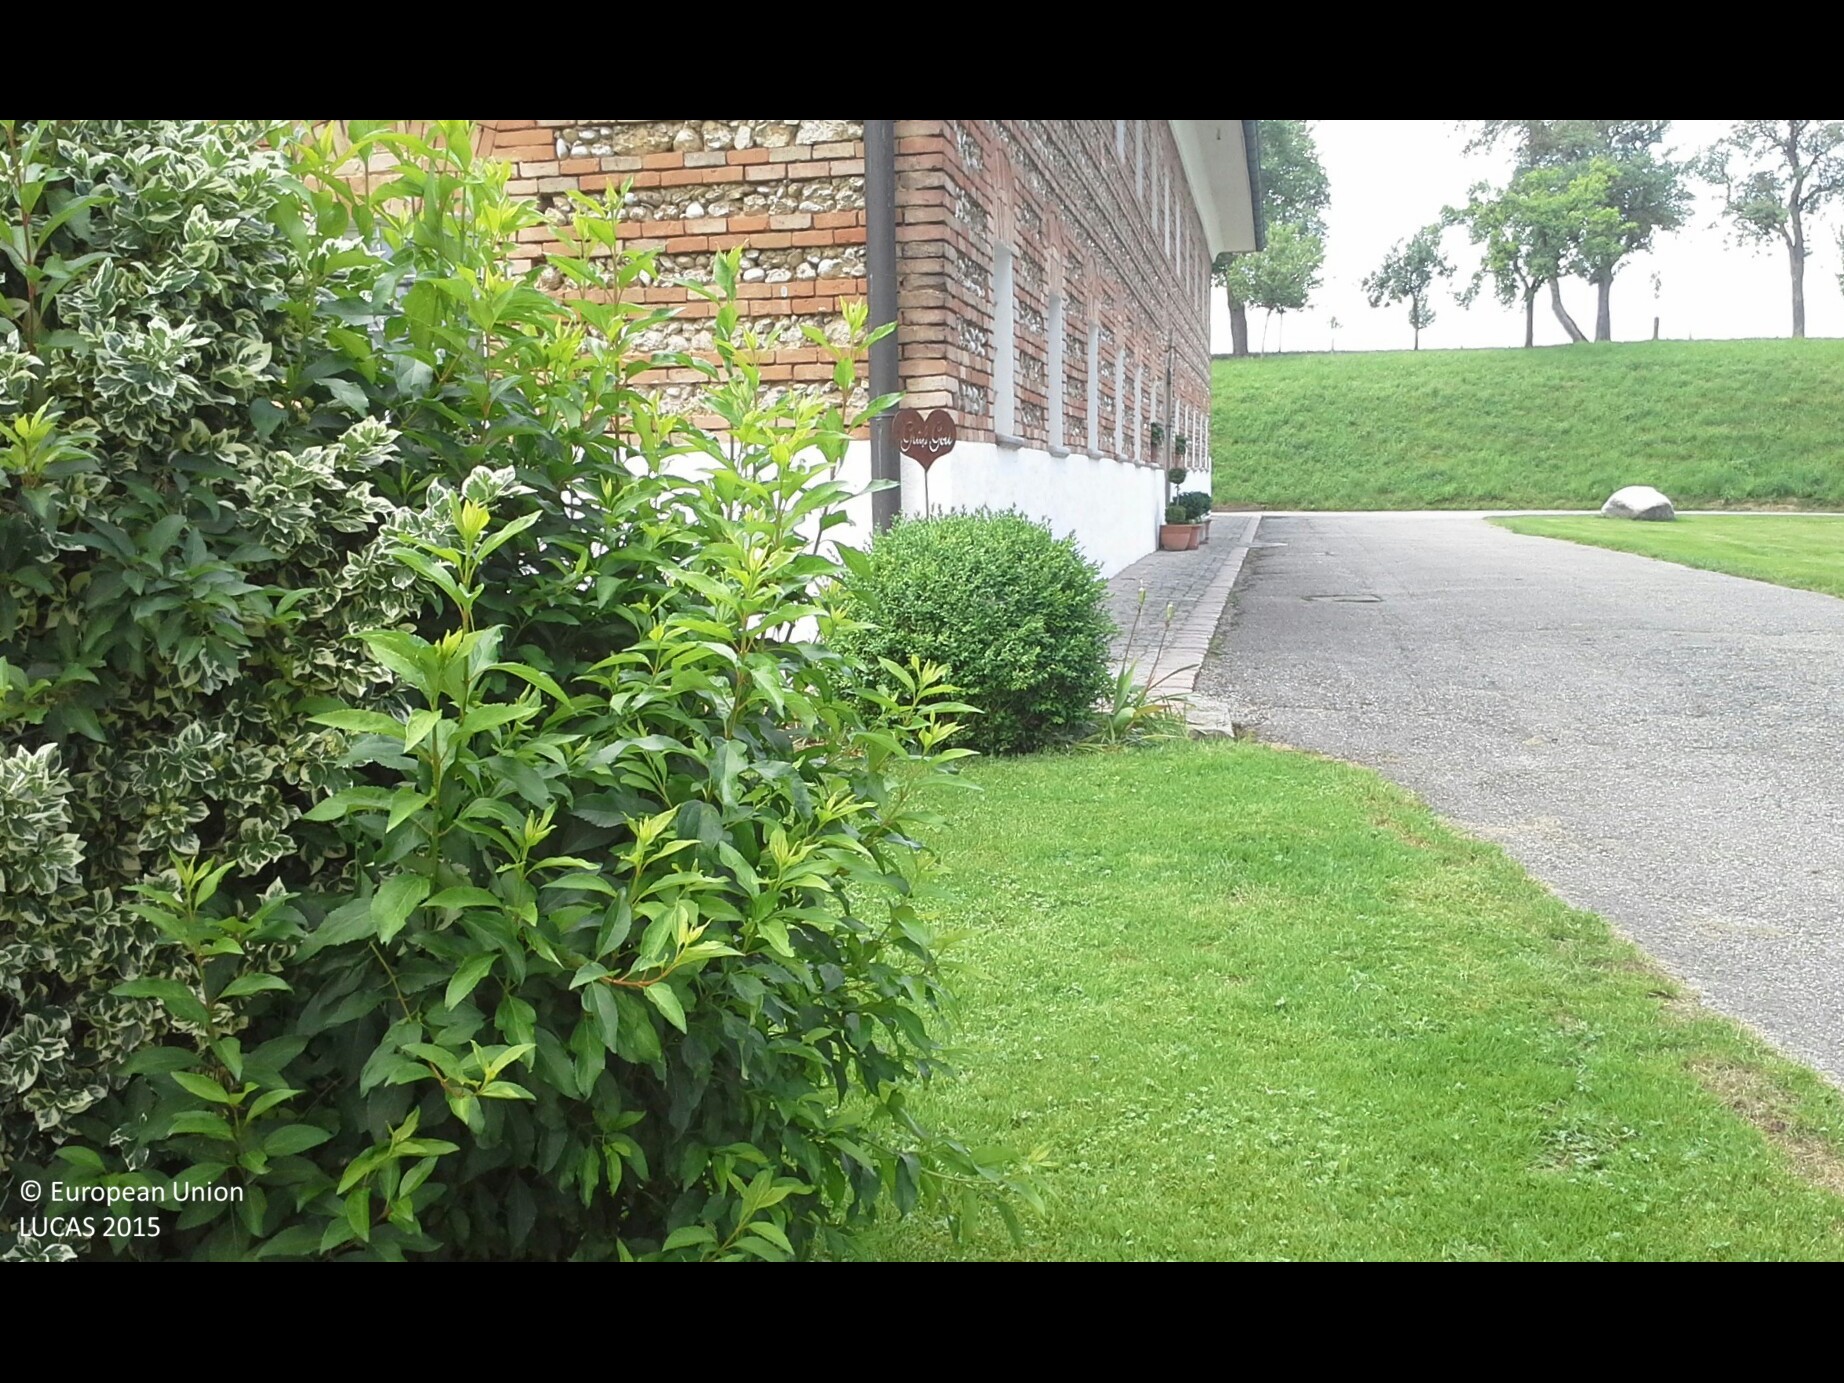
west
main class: Grassland
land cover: Grassland without tree/shrub cover
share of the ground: > 75 %
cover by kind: herbaceous plants 100 %
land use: Residential
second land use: Agriculture (excluding fallow land and kitchen gardens)
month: June
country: AT
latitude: 48.0853
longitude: 14.3092
